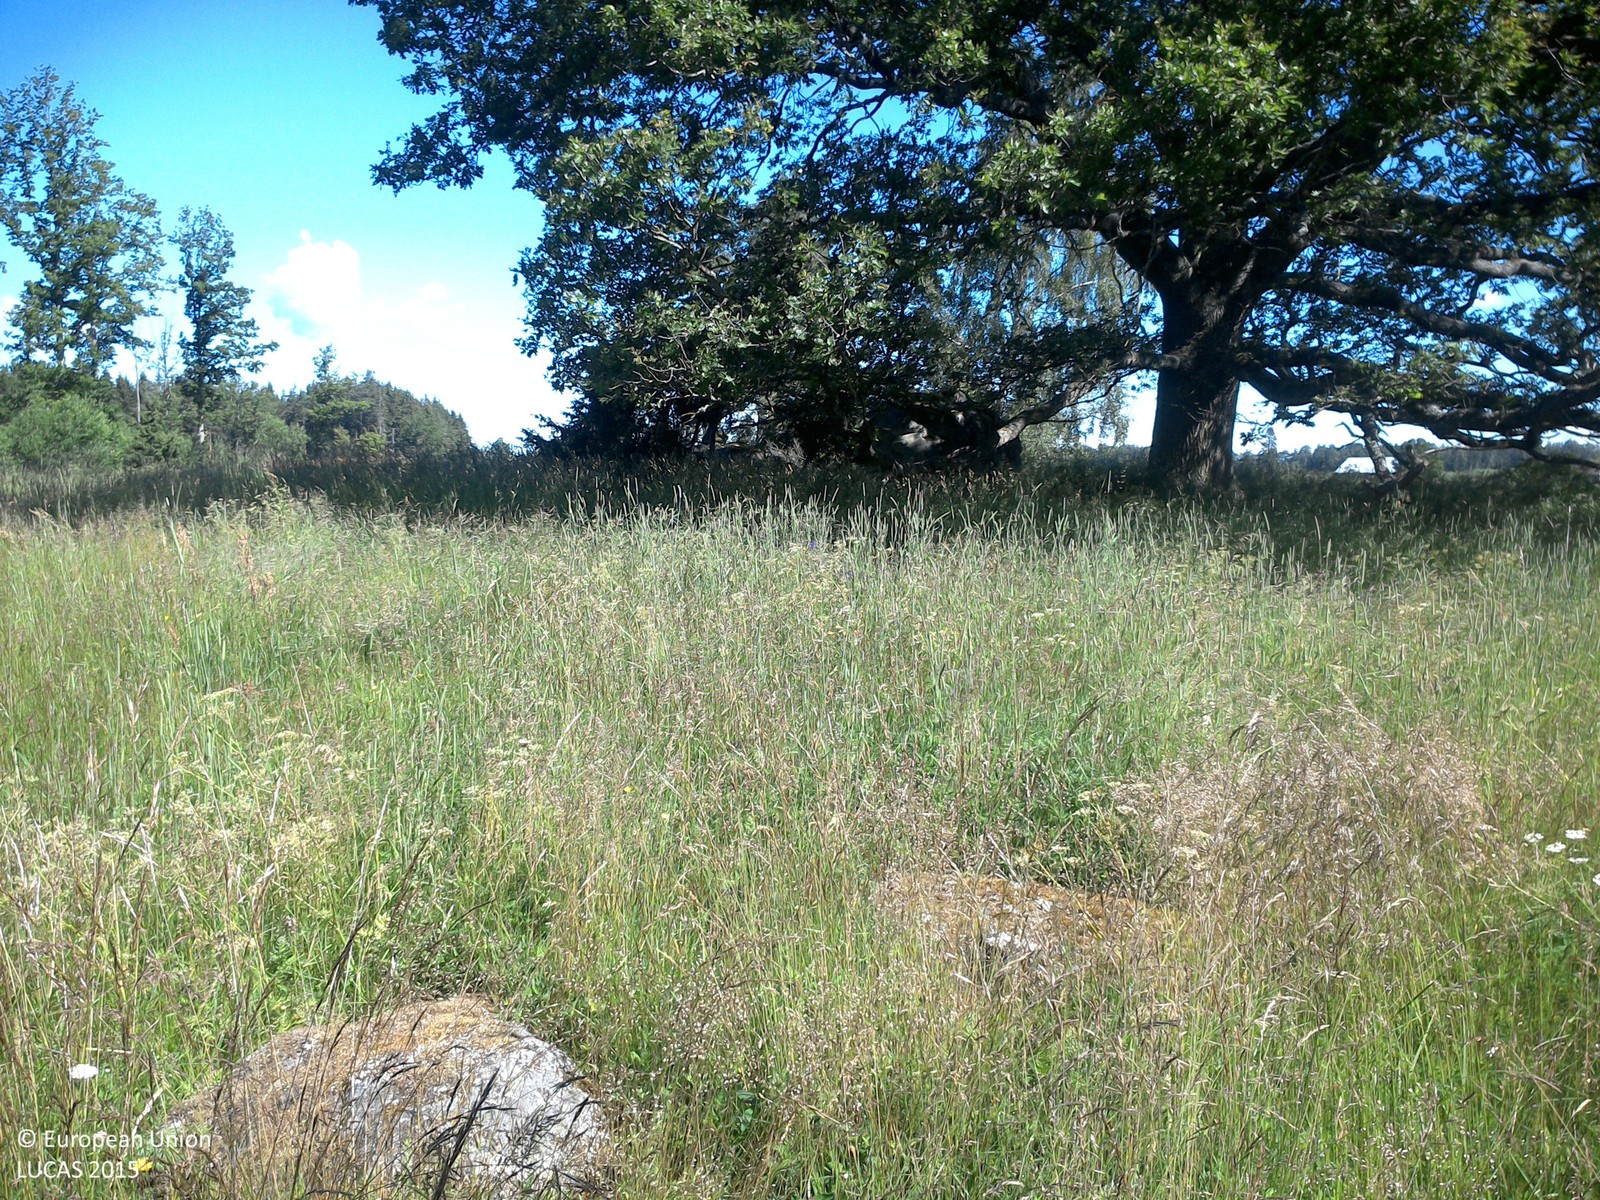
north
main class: Grassland
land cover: Grassland with sparse tree/shrub cover
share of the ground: > 75 %
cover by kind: herbaceous plants 95 %, broadleaved forest trees 5 %
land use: Agriculture (excluding fallow land and kitchen gardens)
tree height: > 5 m
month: July
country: SE
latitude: 58.4016
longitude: 15.3501
